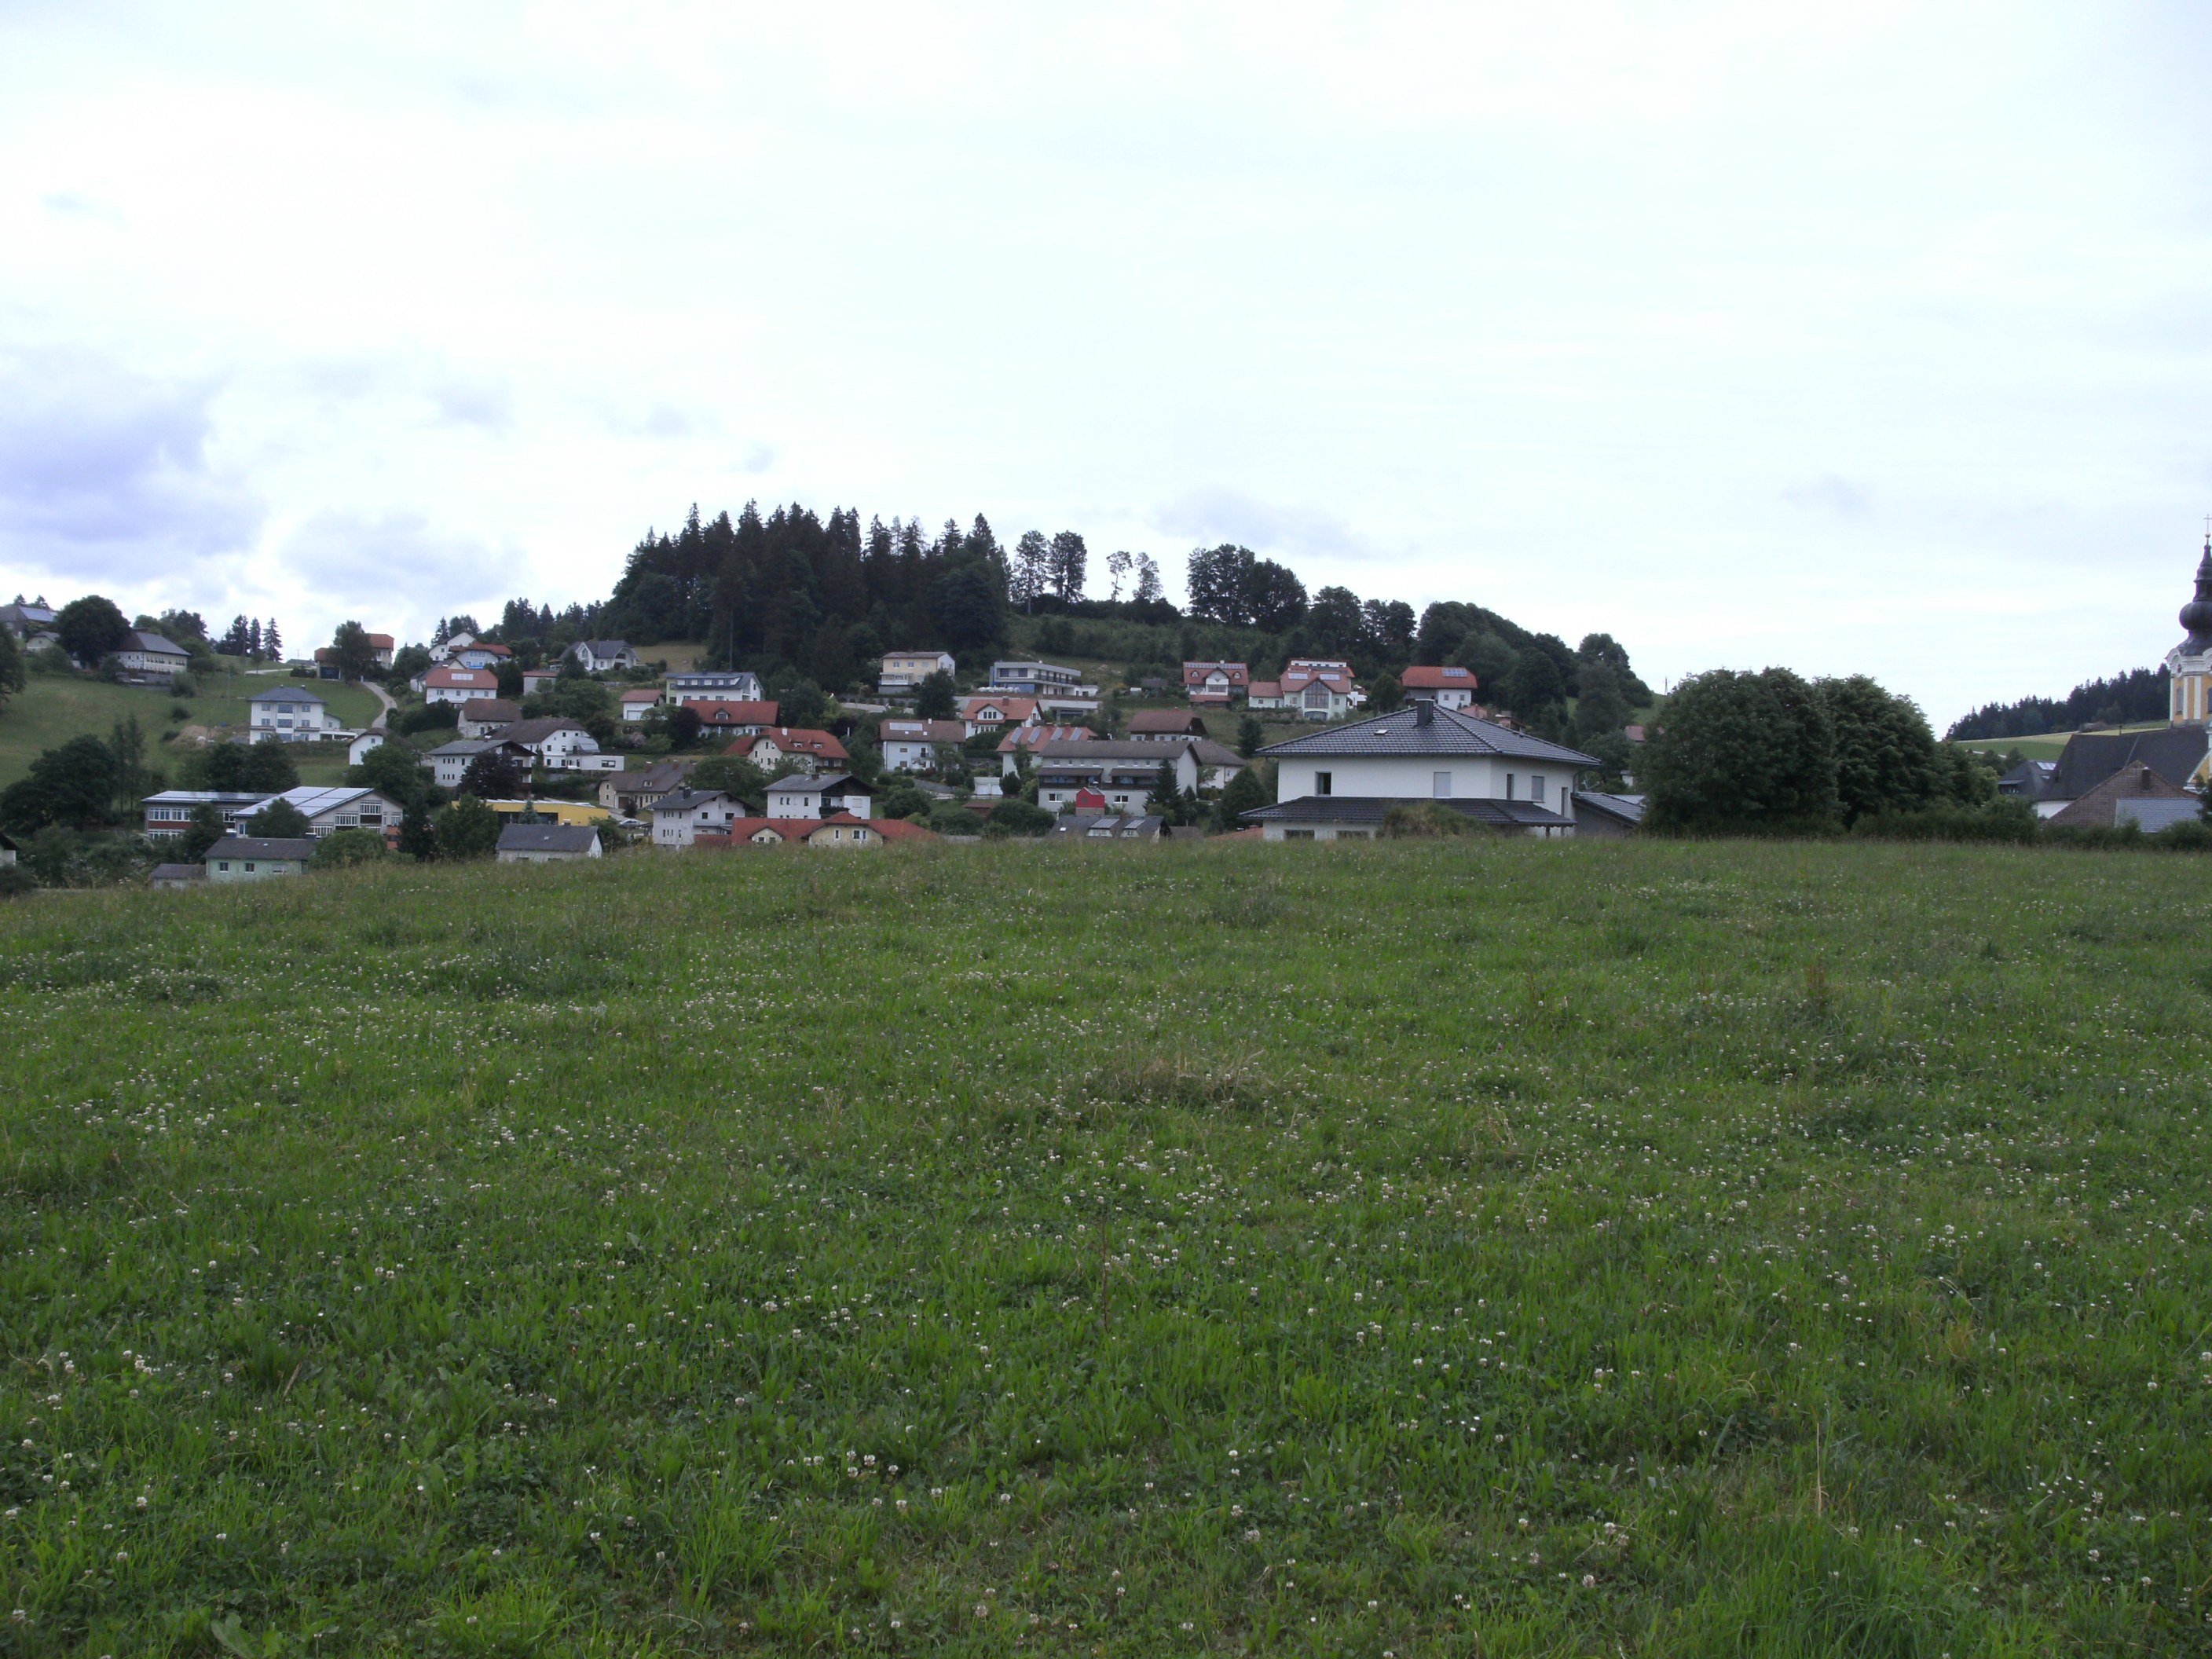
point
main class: Grassland
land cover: Grassland without tree/shrub cover
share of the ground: > 75 %
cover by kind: herbaceous plants 100 %
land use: Agriculture (excluding fallow land and kitchen gardens)
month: June
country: AT
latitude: 48.4886
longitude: 14.1270
